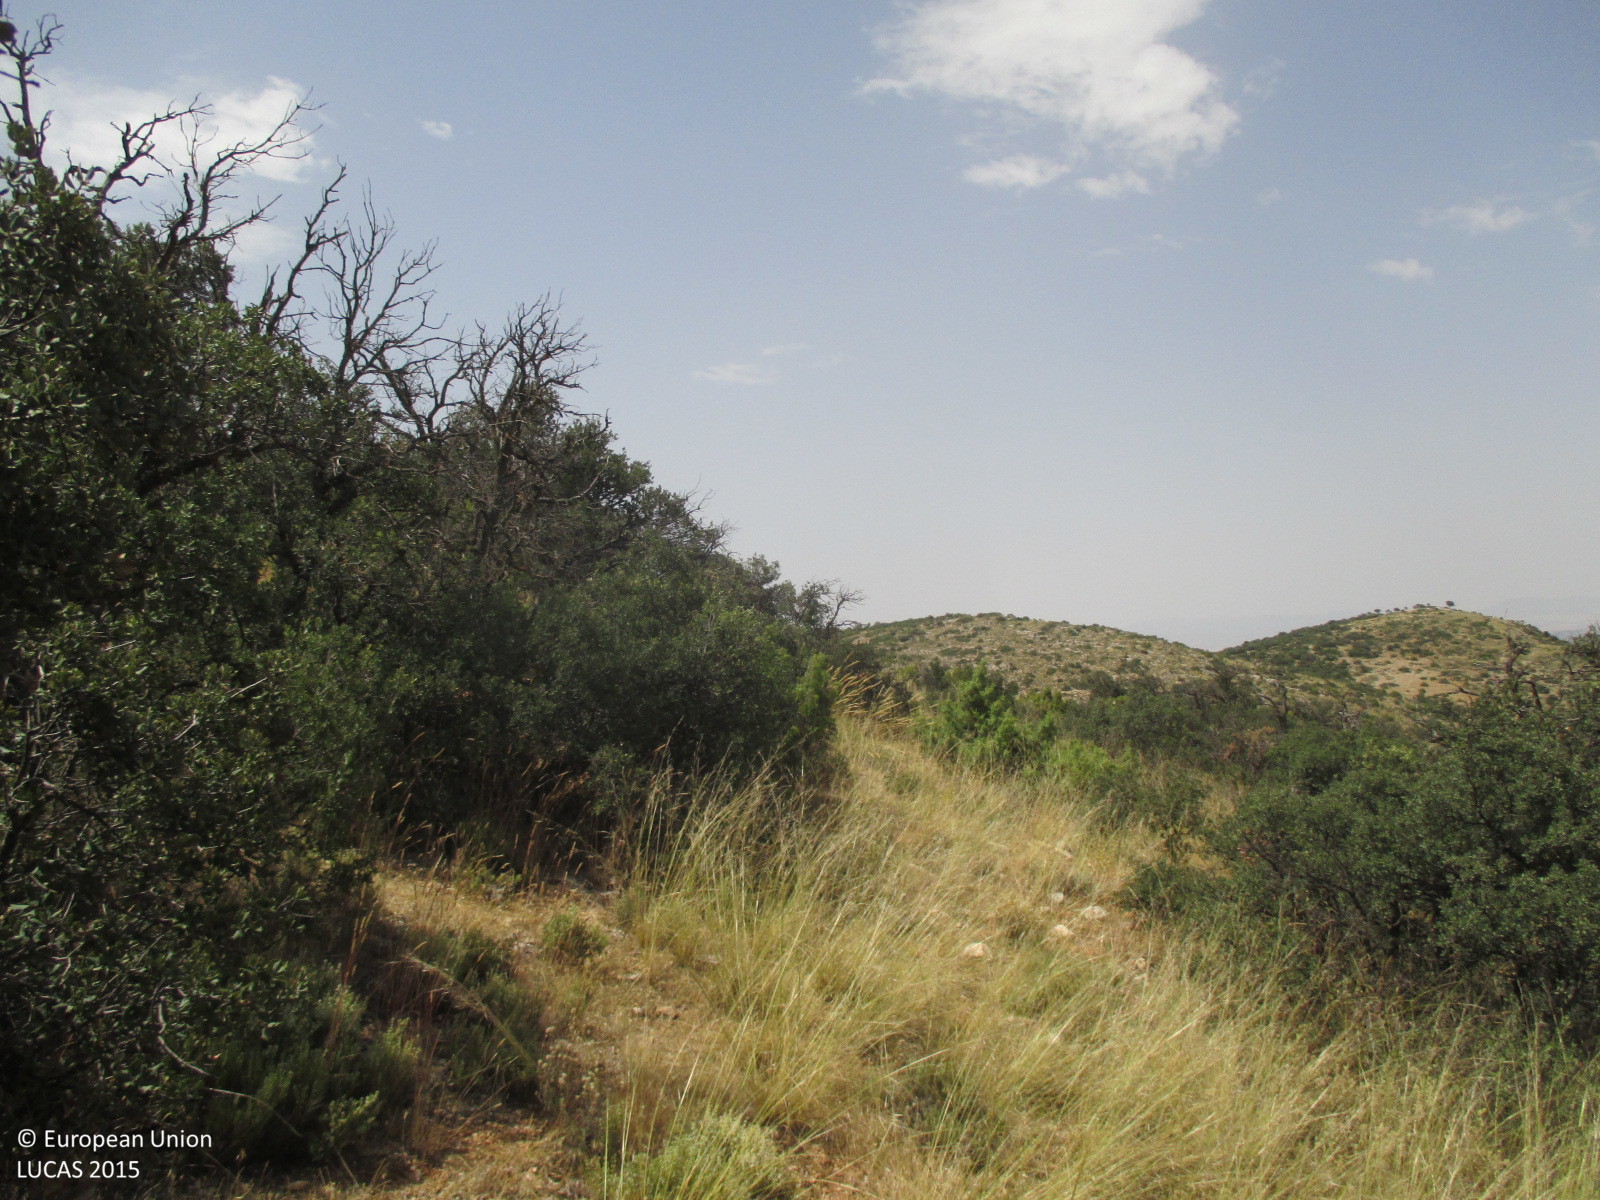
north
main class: Woodland
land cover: Broadleaved woodland
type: broadleaved evergreen forest
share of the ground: 50 - 75 %
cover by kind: broadleaved forest trees 60 %, shrubs 20 %, herbaceous plants 20 %
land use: Semi-natural and natural areas not in use
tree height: < 5 m
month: June
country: ES
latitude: 37.6326
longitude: -2.3716
